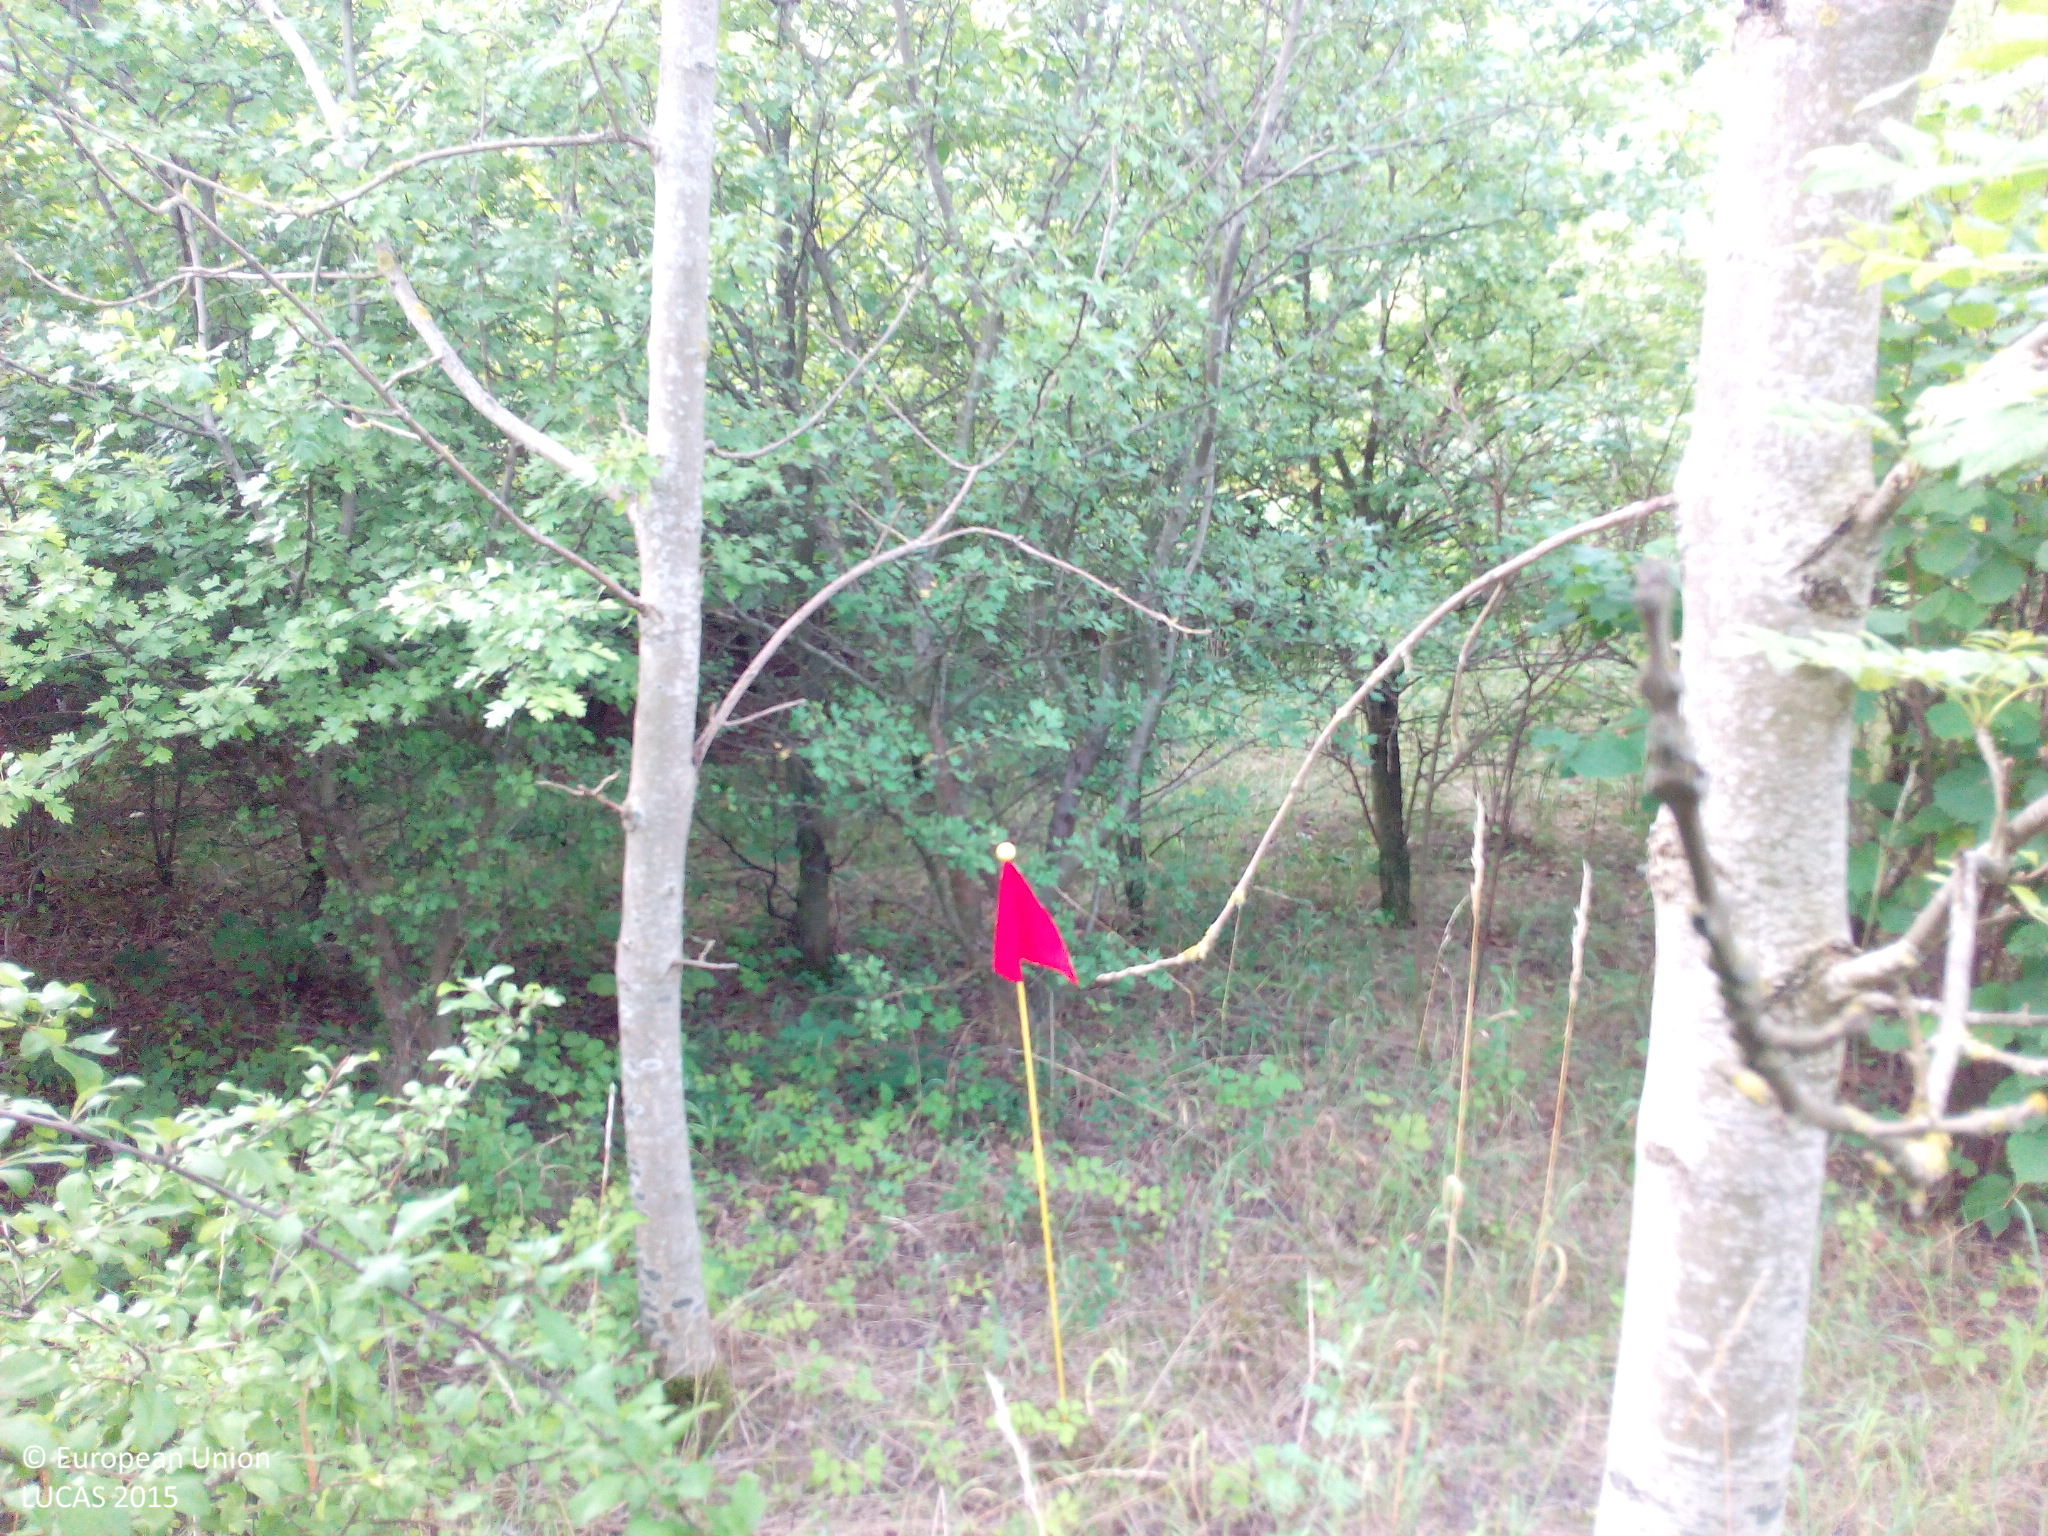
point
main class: Woodland
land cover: Broadleaved woodland
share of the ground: 10 - 25 %
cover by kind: shrubs 70 %, broadleaved forest trees 20 %, herbaceous plants 10 %
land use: Semi-natural and natural areas not in use
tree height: < 5 m
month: July
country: DE
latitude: 52.2213
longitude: 11.7122
